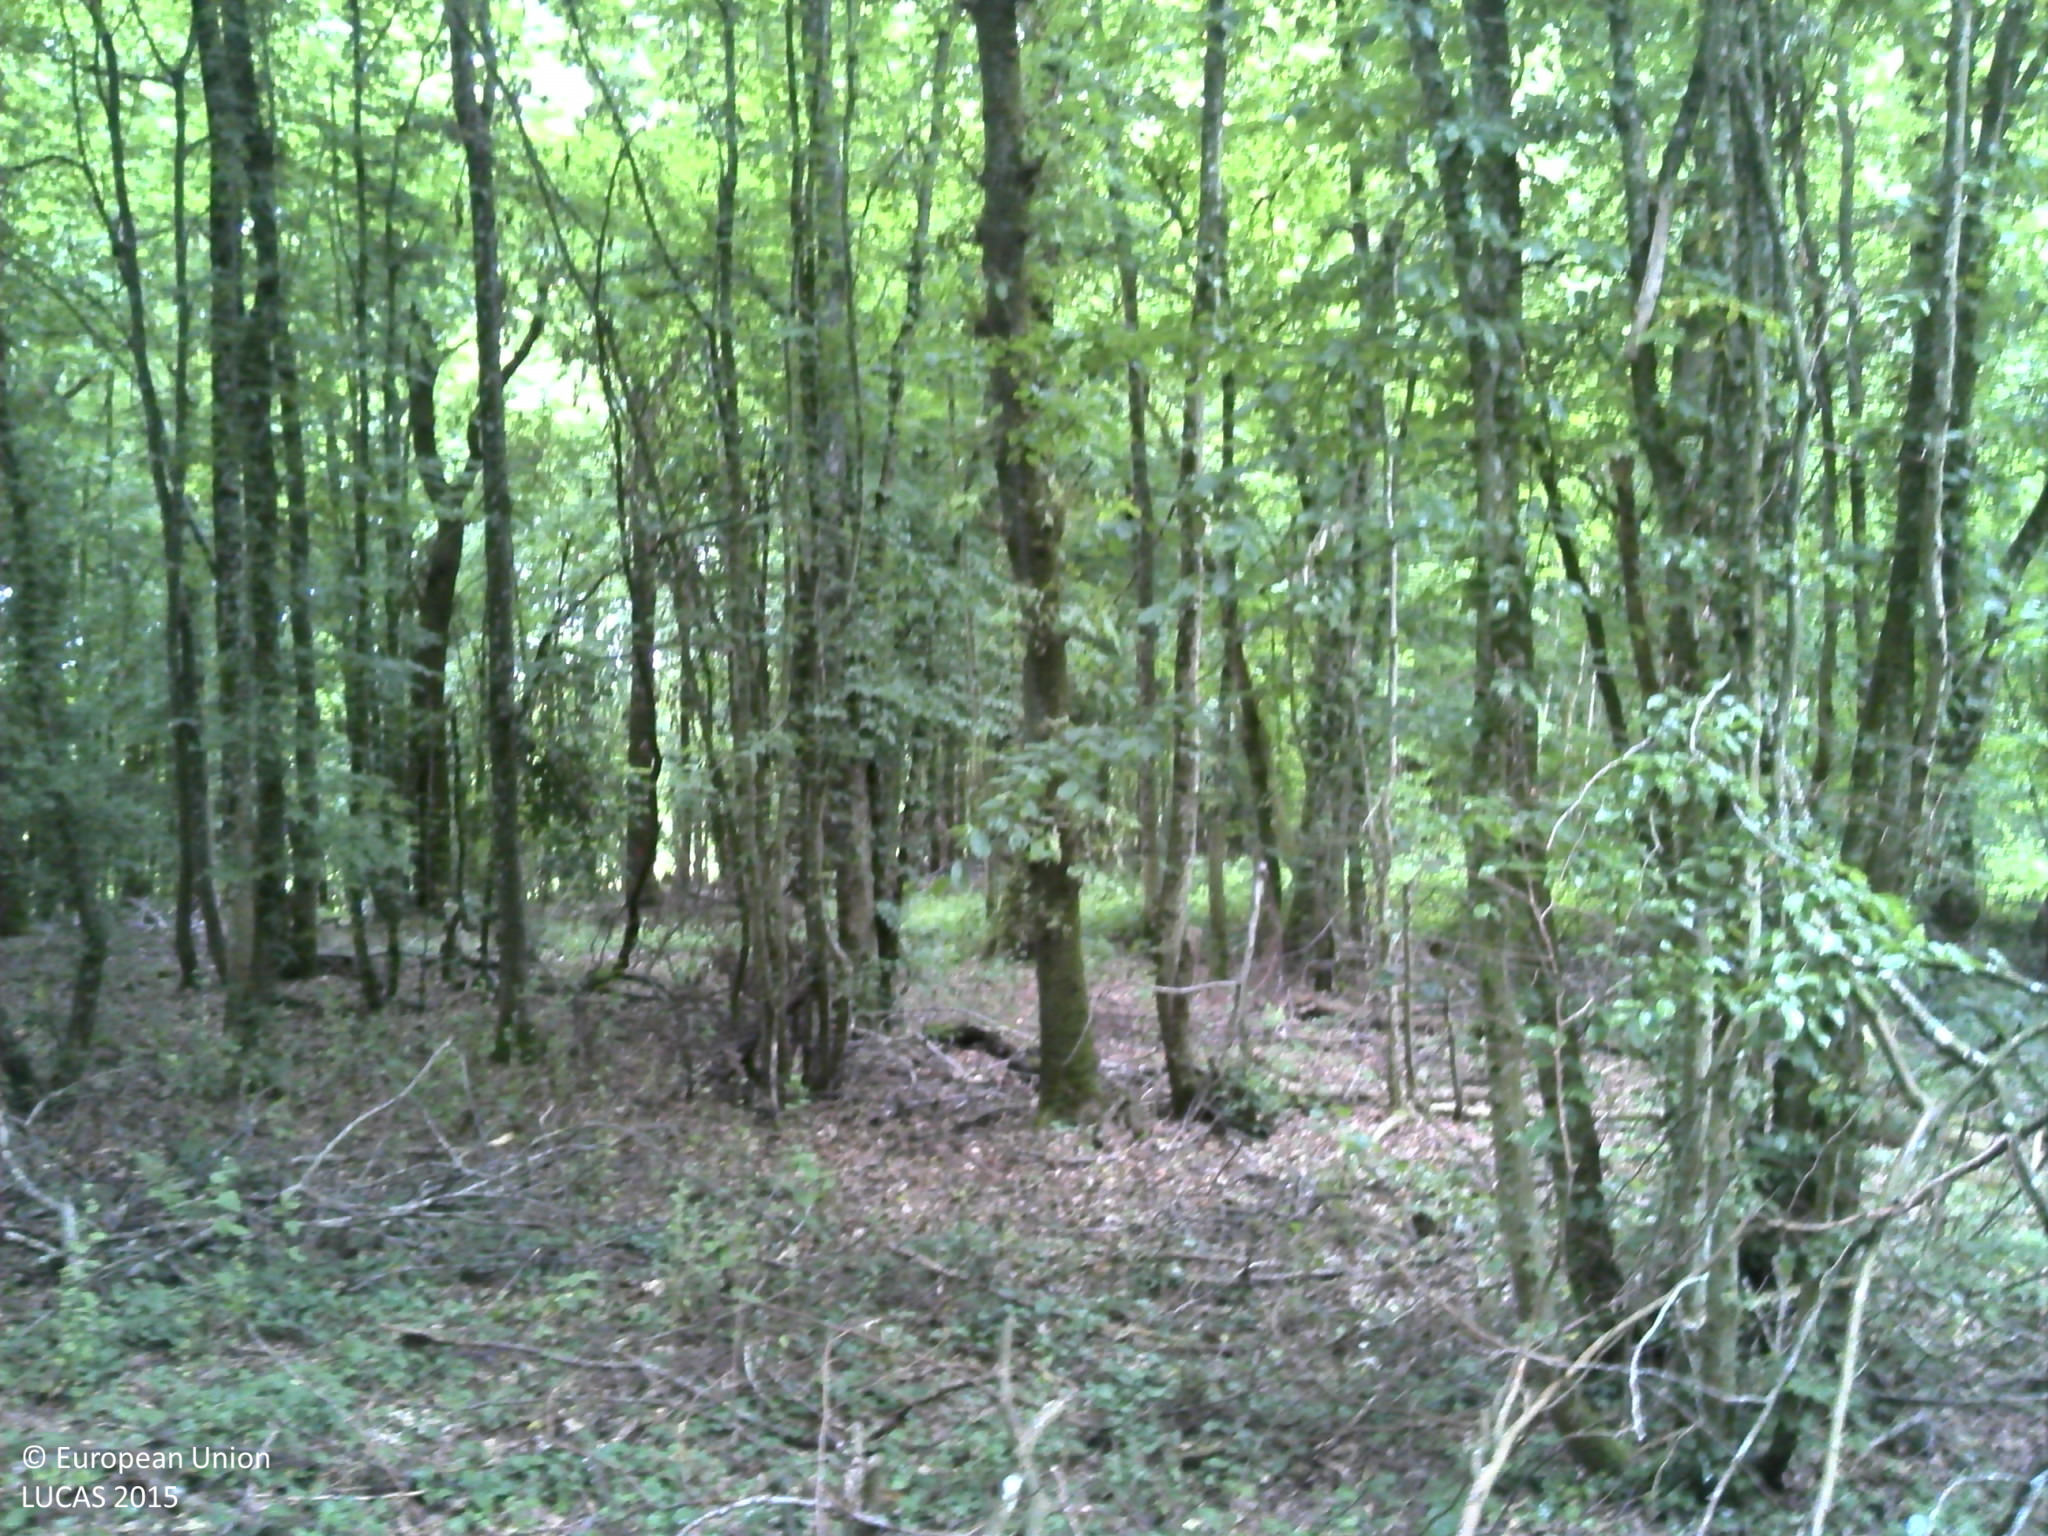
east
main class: Woodland
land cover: Broadleaved woodland
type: acidophilous oak and oak-birch forest
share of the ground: > 75 %
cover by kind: broadleaved forest trees 65 %, herbaceous plants 15 %, consolidated bare surface 15 %, lichens and mosses 5 %
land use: Forestry
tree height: > 5 m
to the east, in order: Broadleaved woodland; Tracks; Broadleaved woodland; Grassland with sparse tree/shrub cover; Electric lines; Grassland with sparse tree/shrub cover; Broadleaved woodland; Tracks; Broadleaved woodland
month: July
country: FR
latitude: 49.7843
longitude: 4.5657
